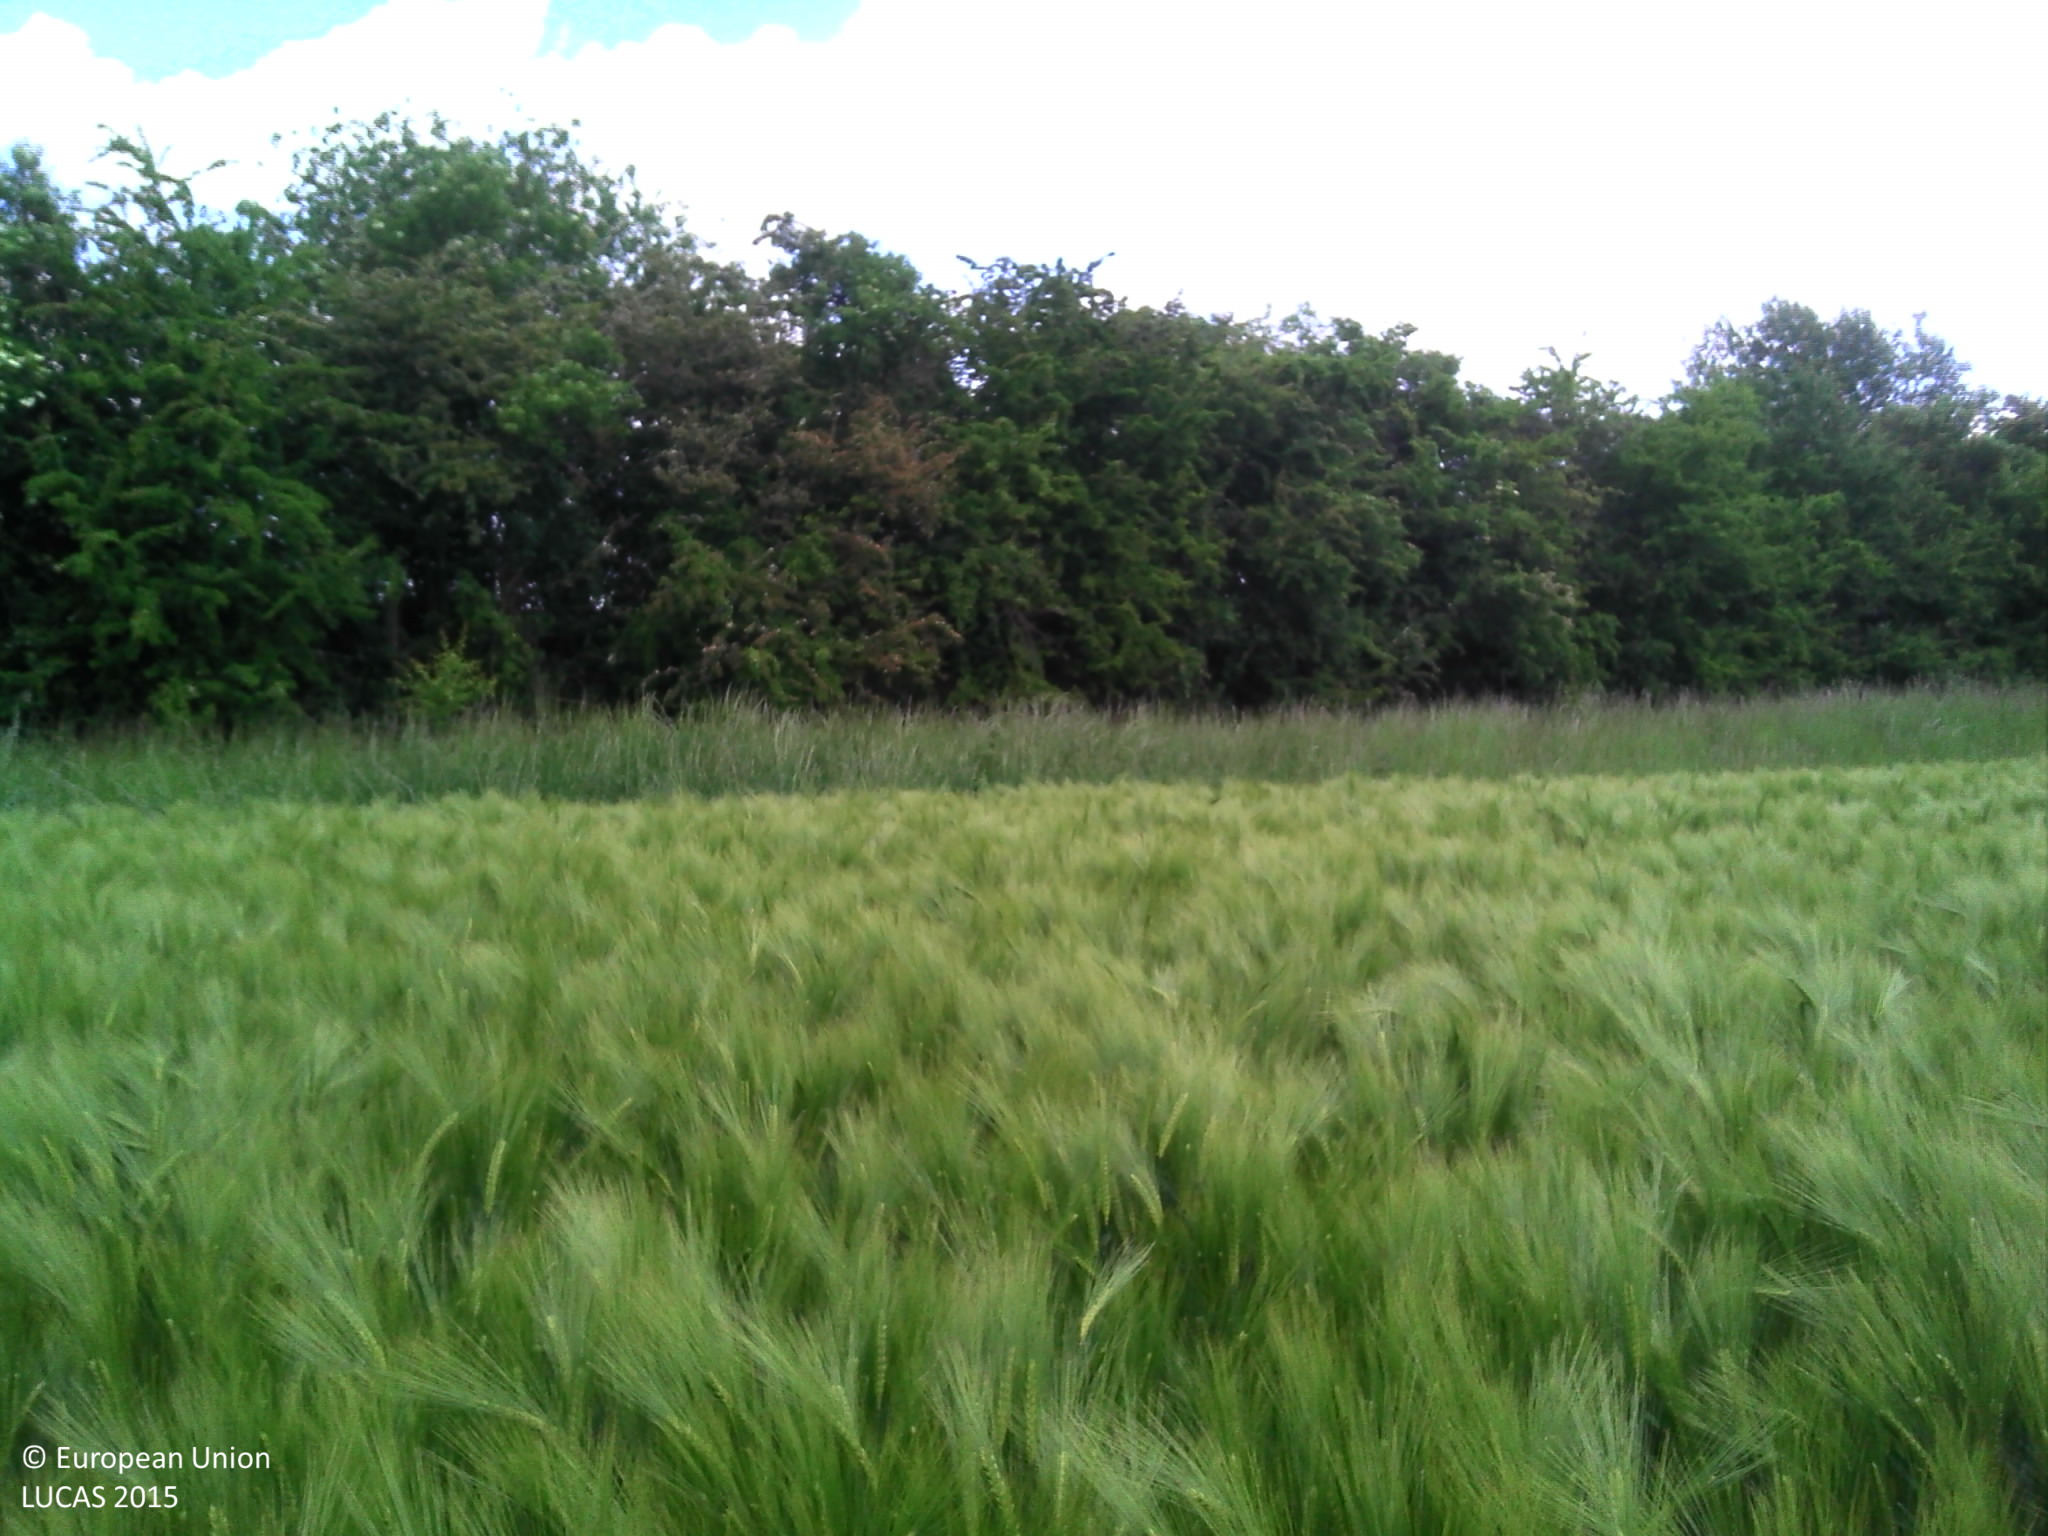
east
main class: Cropland
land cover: Barley
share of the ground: > 75 %
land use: Agriculture (excluding fallow land and kitchen gardens)
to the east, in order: Barley; Grassland without tree/shrub cover; Broadleaved woodland; Maize; Rape and turnip rape
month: May
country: BE
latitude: 50.5372
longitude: 4.4790
